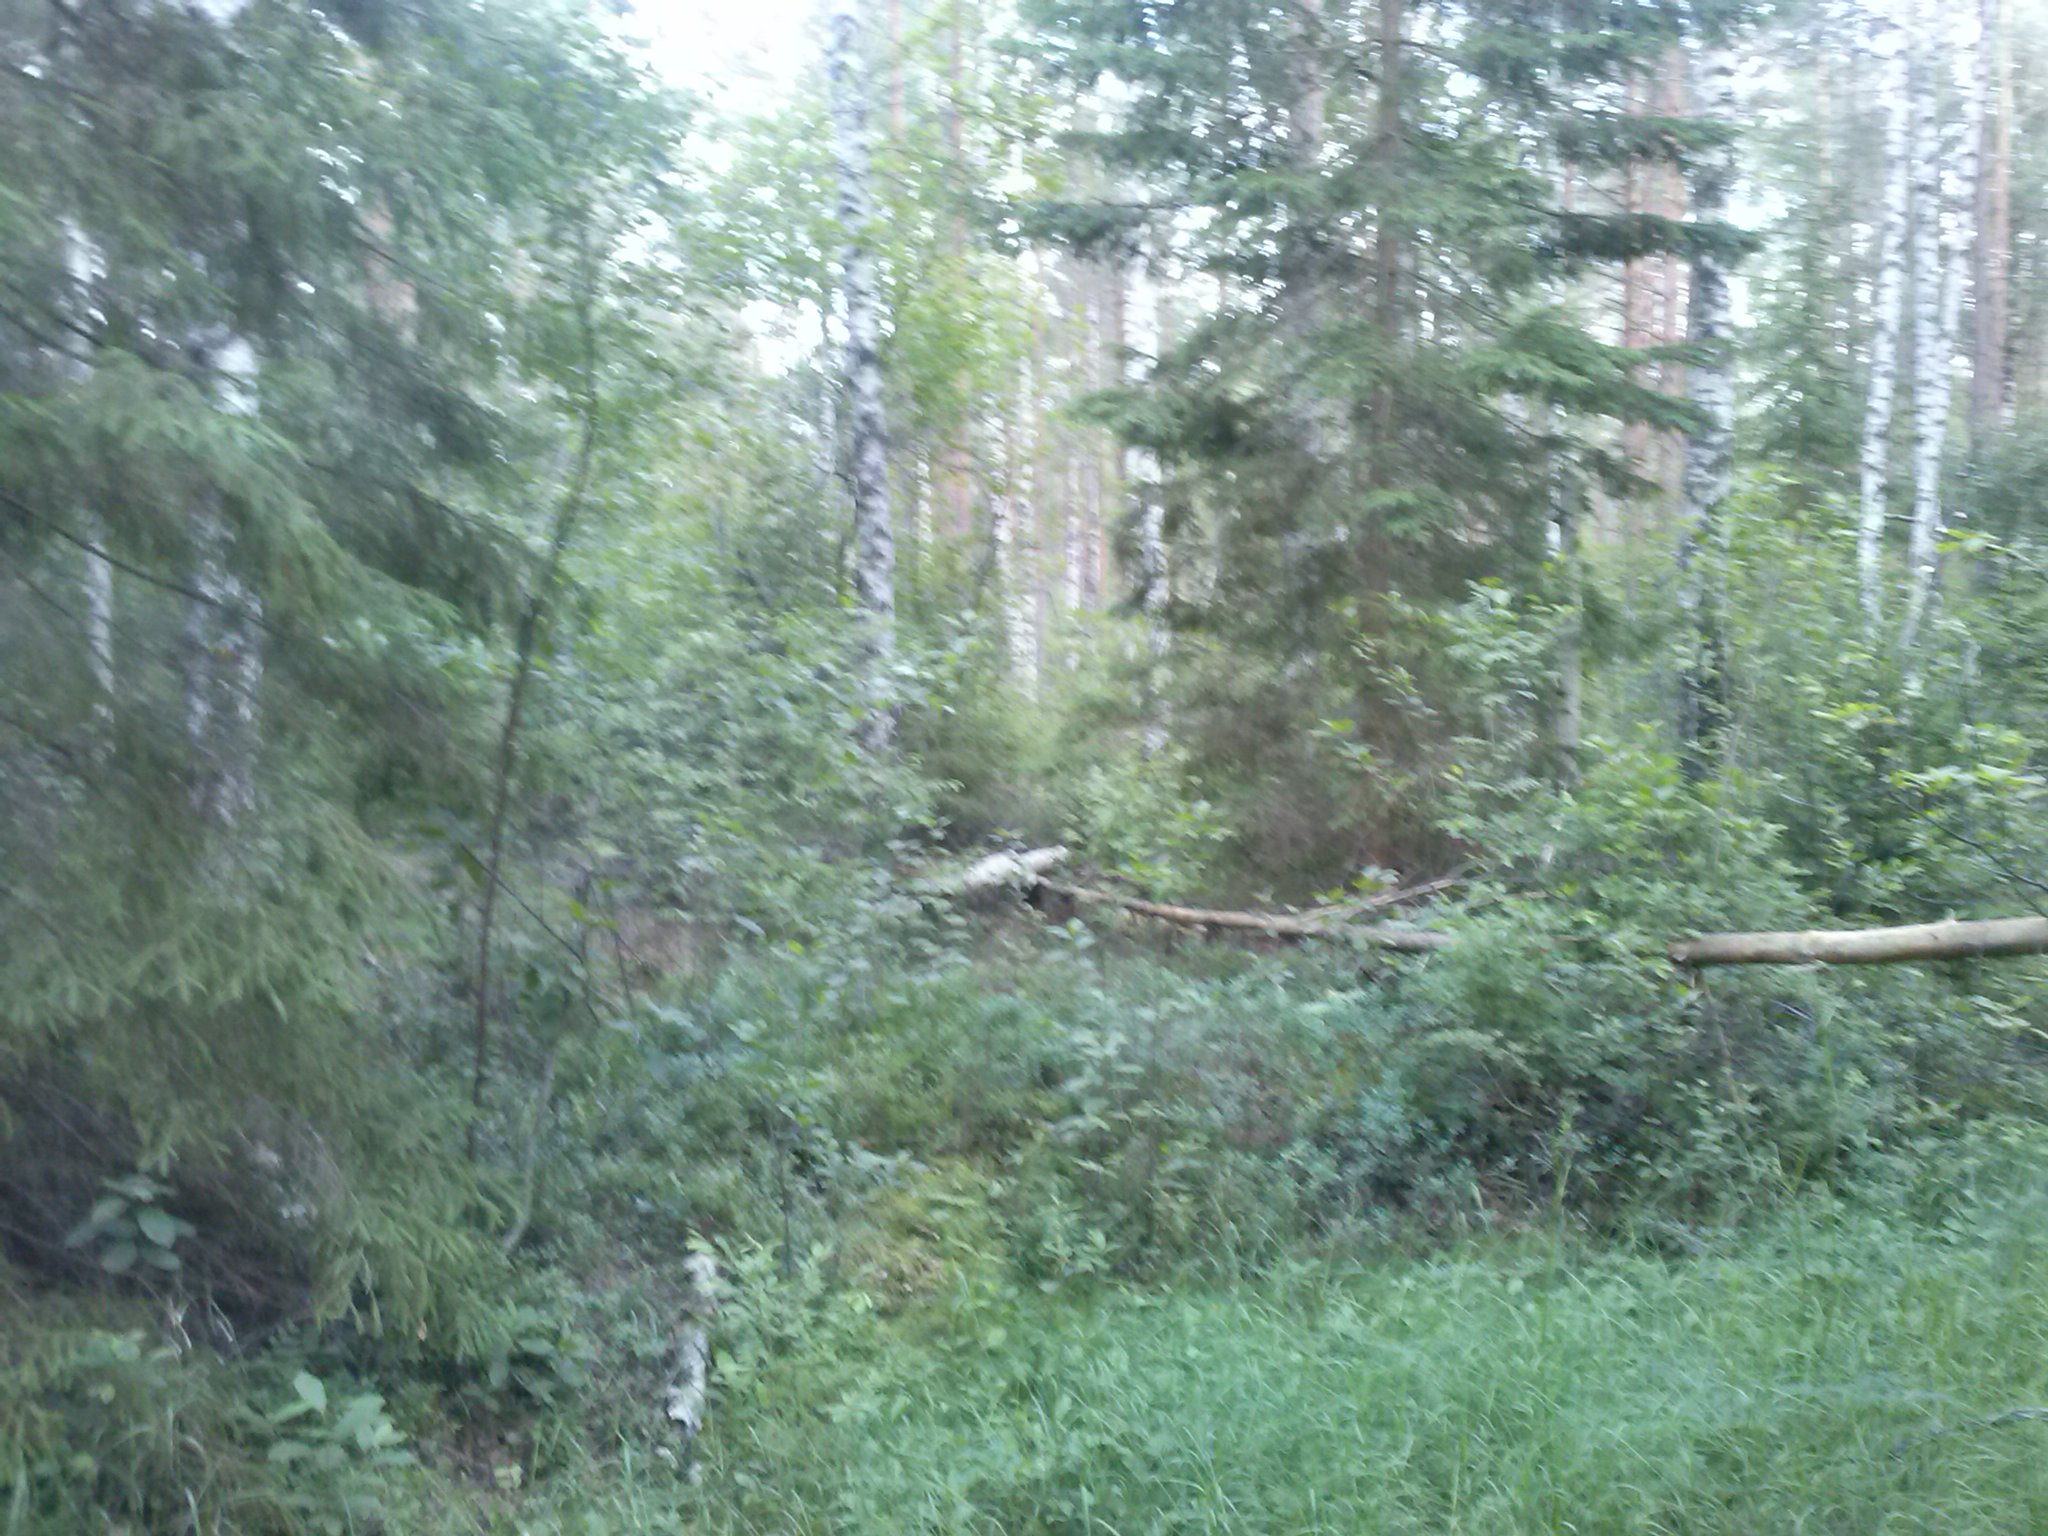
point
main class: Woodland
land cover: Spruce dominated mixed woodland
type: hemiboreal forest and nemoral coniferous forest and mixed broadleaved-coniferous forest
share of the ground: > 75 %
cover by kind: coniferous forest trees 50 %, broadleaved forest trees 30 %, herbaceous plants 20 %
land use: Forestry
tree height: > 5 m
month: July
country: LV
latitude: 56.8126
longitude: 27.7967
